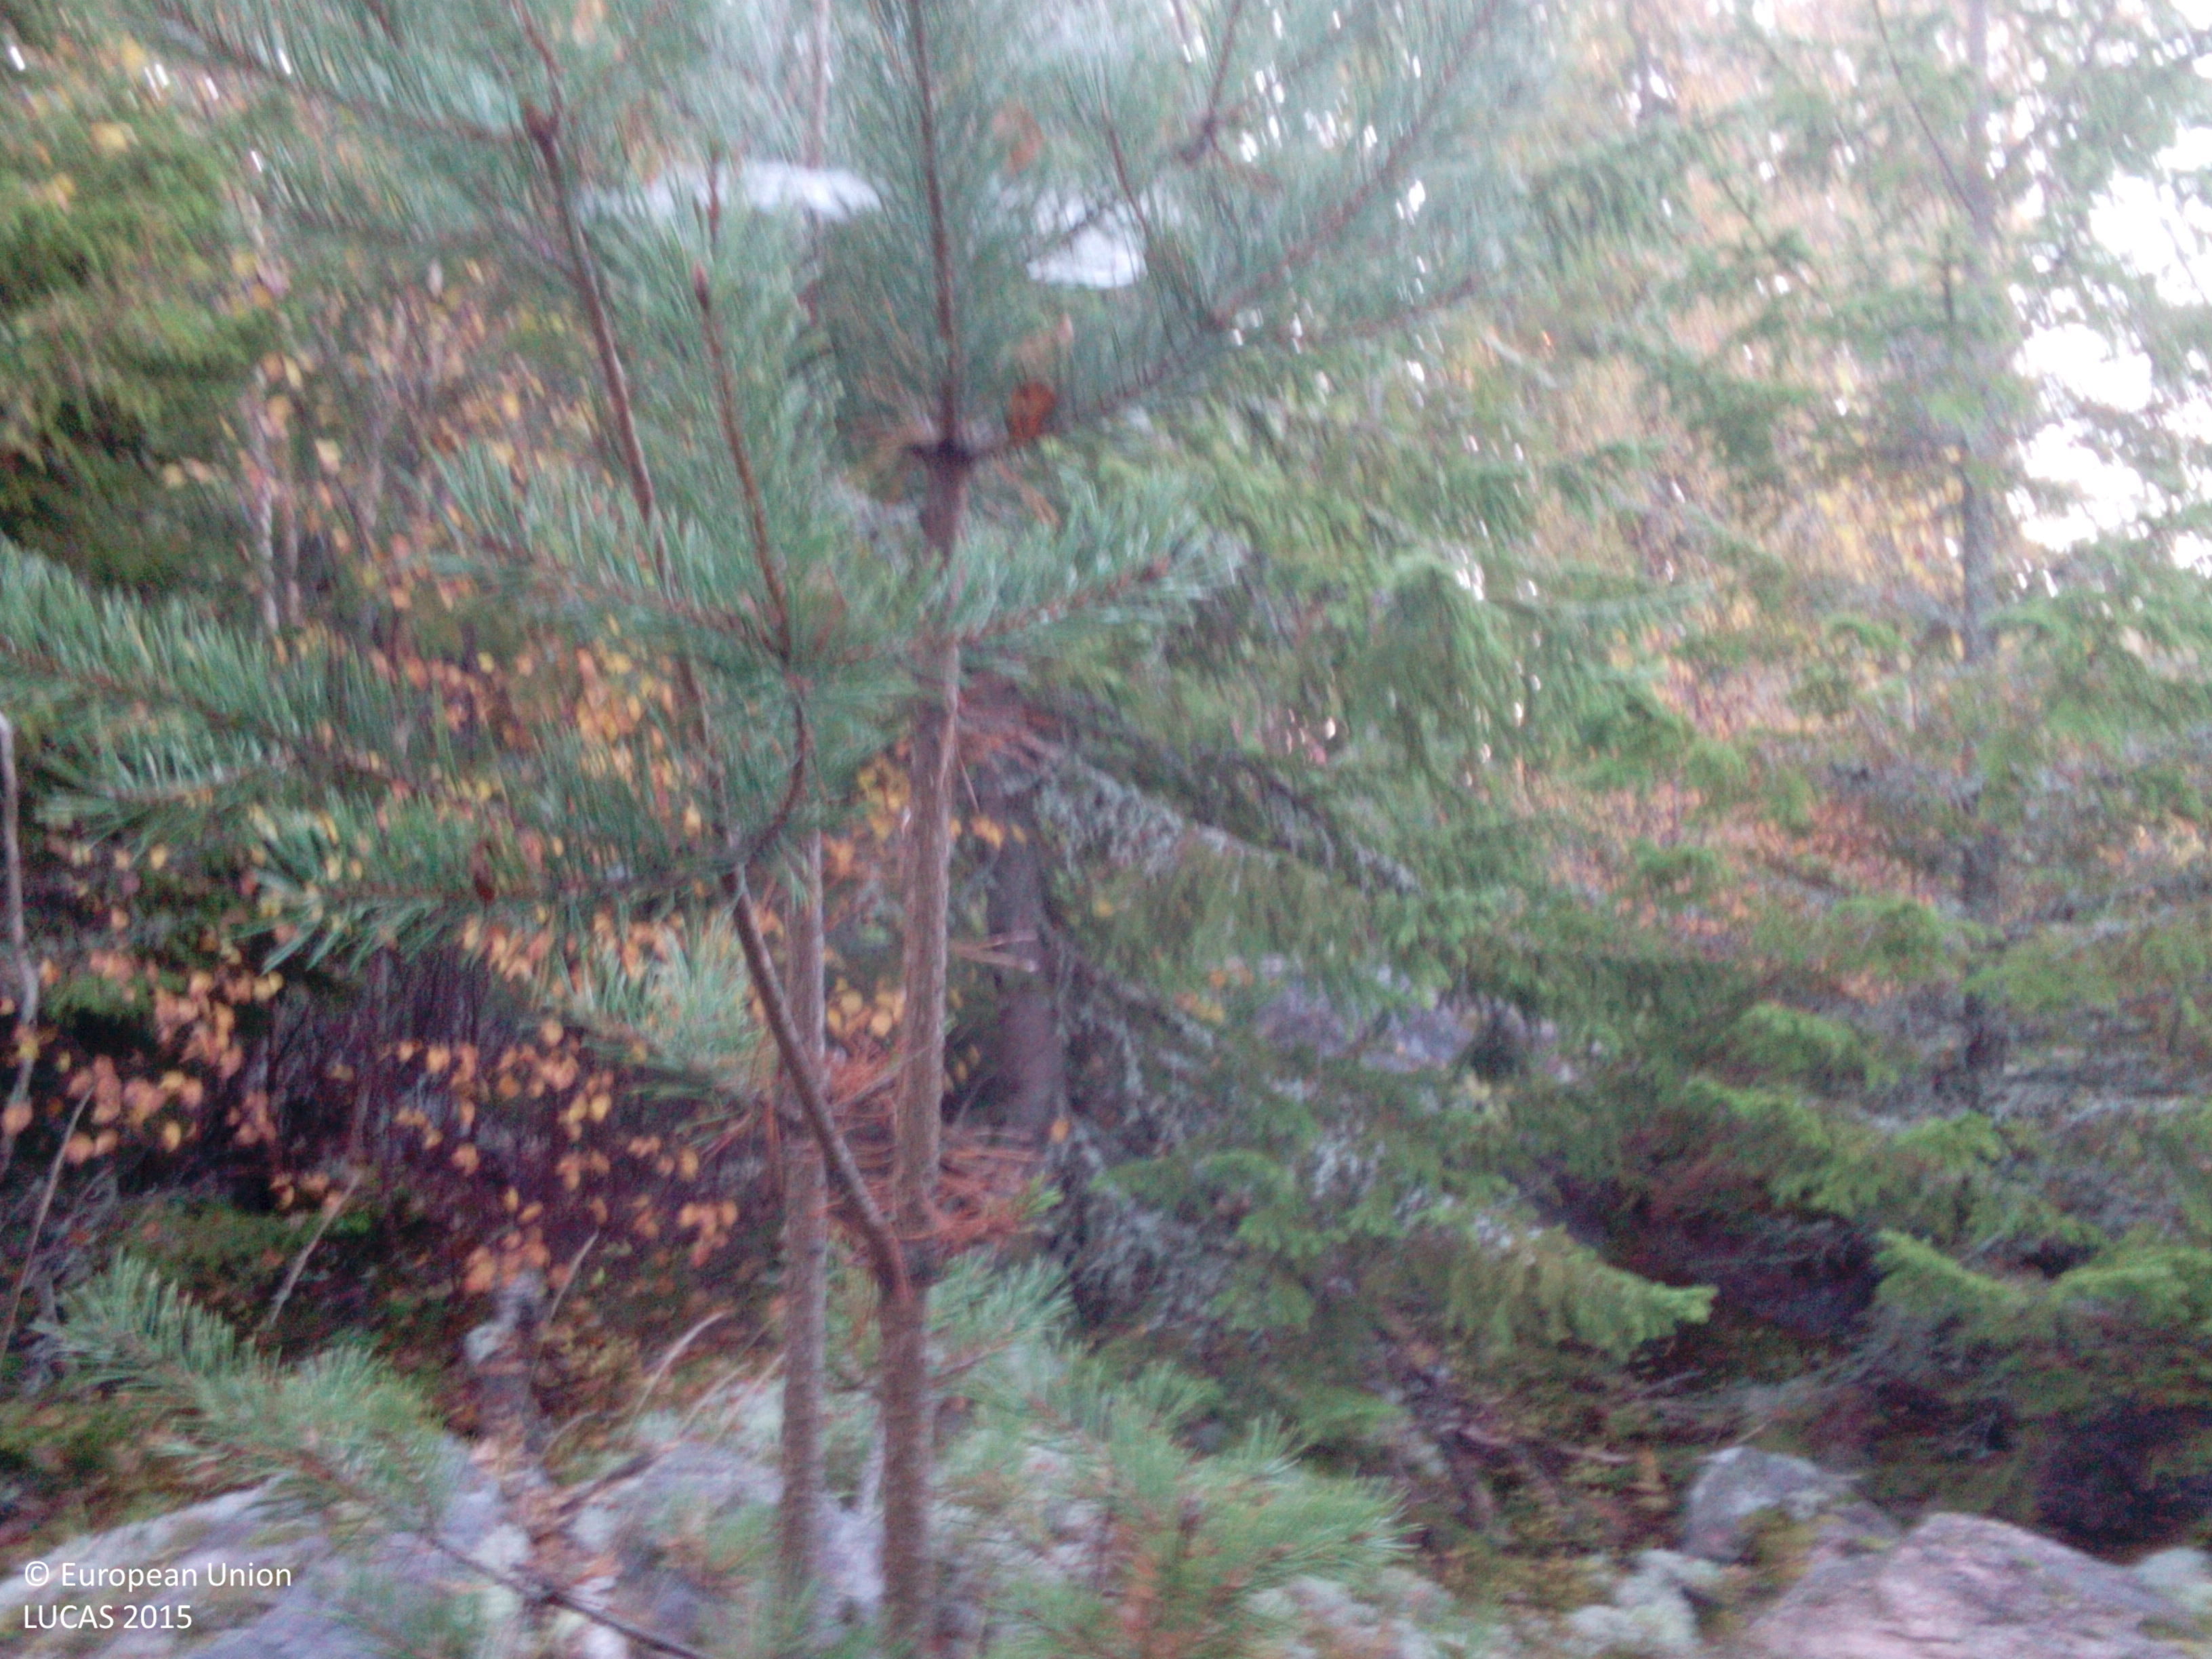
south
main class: Woodland
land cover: Spruce dominated coniferous woodland
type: boreal forest
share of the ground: > 75 %
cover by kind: coniferous forest trees 70 %, lichens and mosses 20 %, broadleaved forest trees 10 %
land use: Forestry
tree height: > 5 m
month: October
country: SE
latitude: 59.1205
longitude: 16.2646
